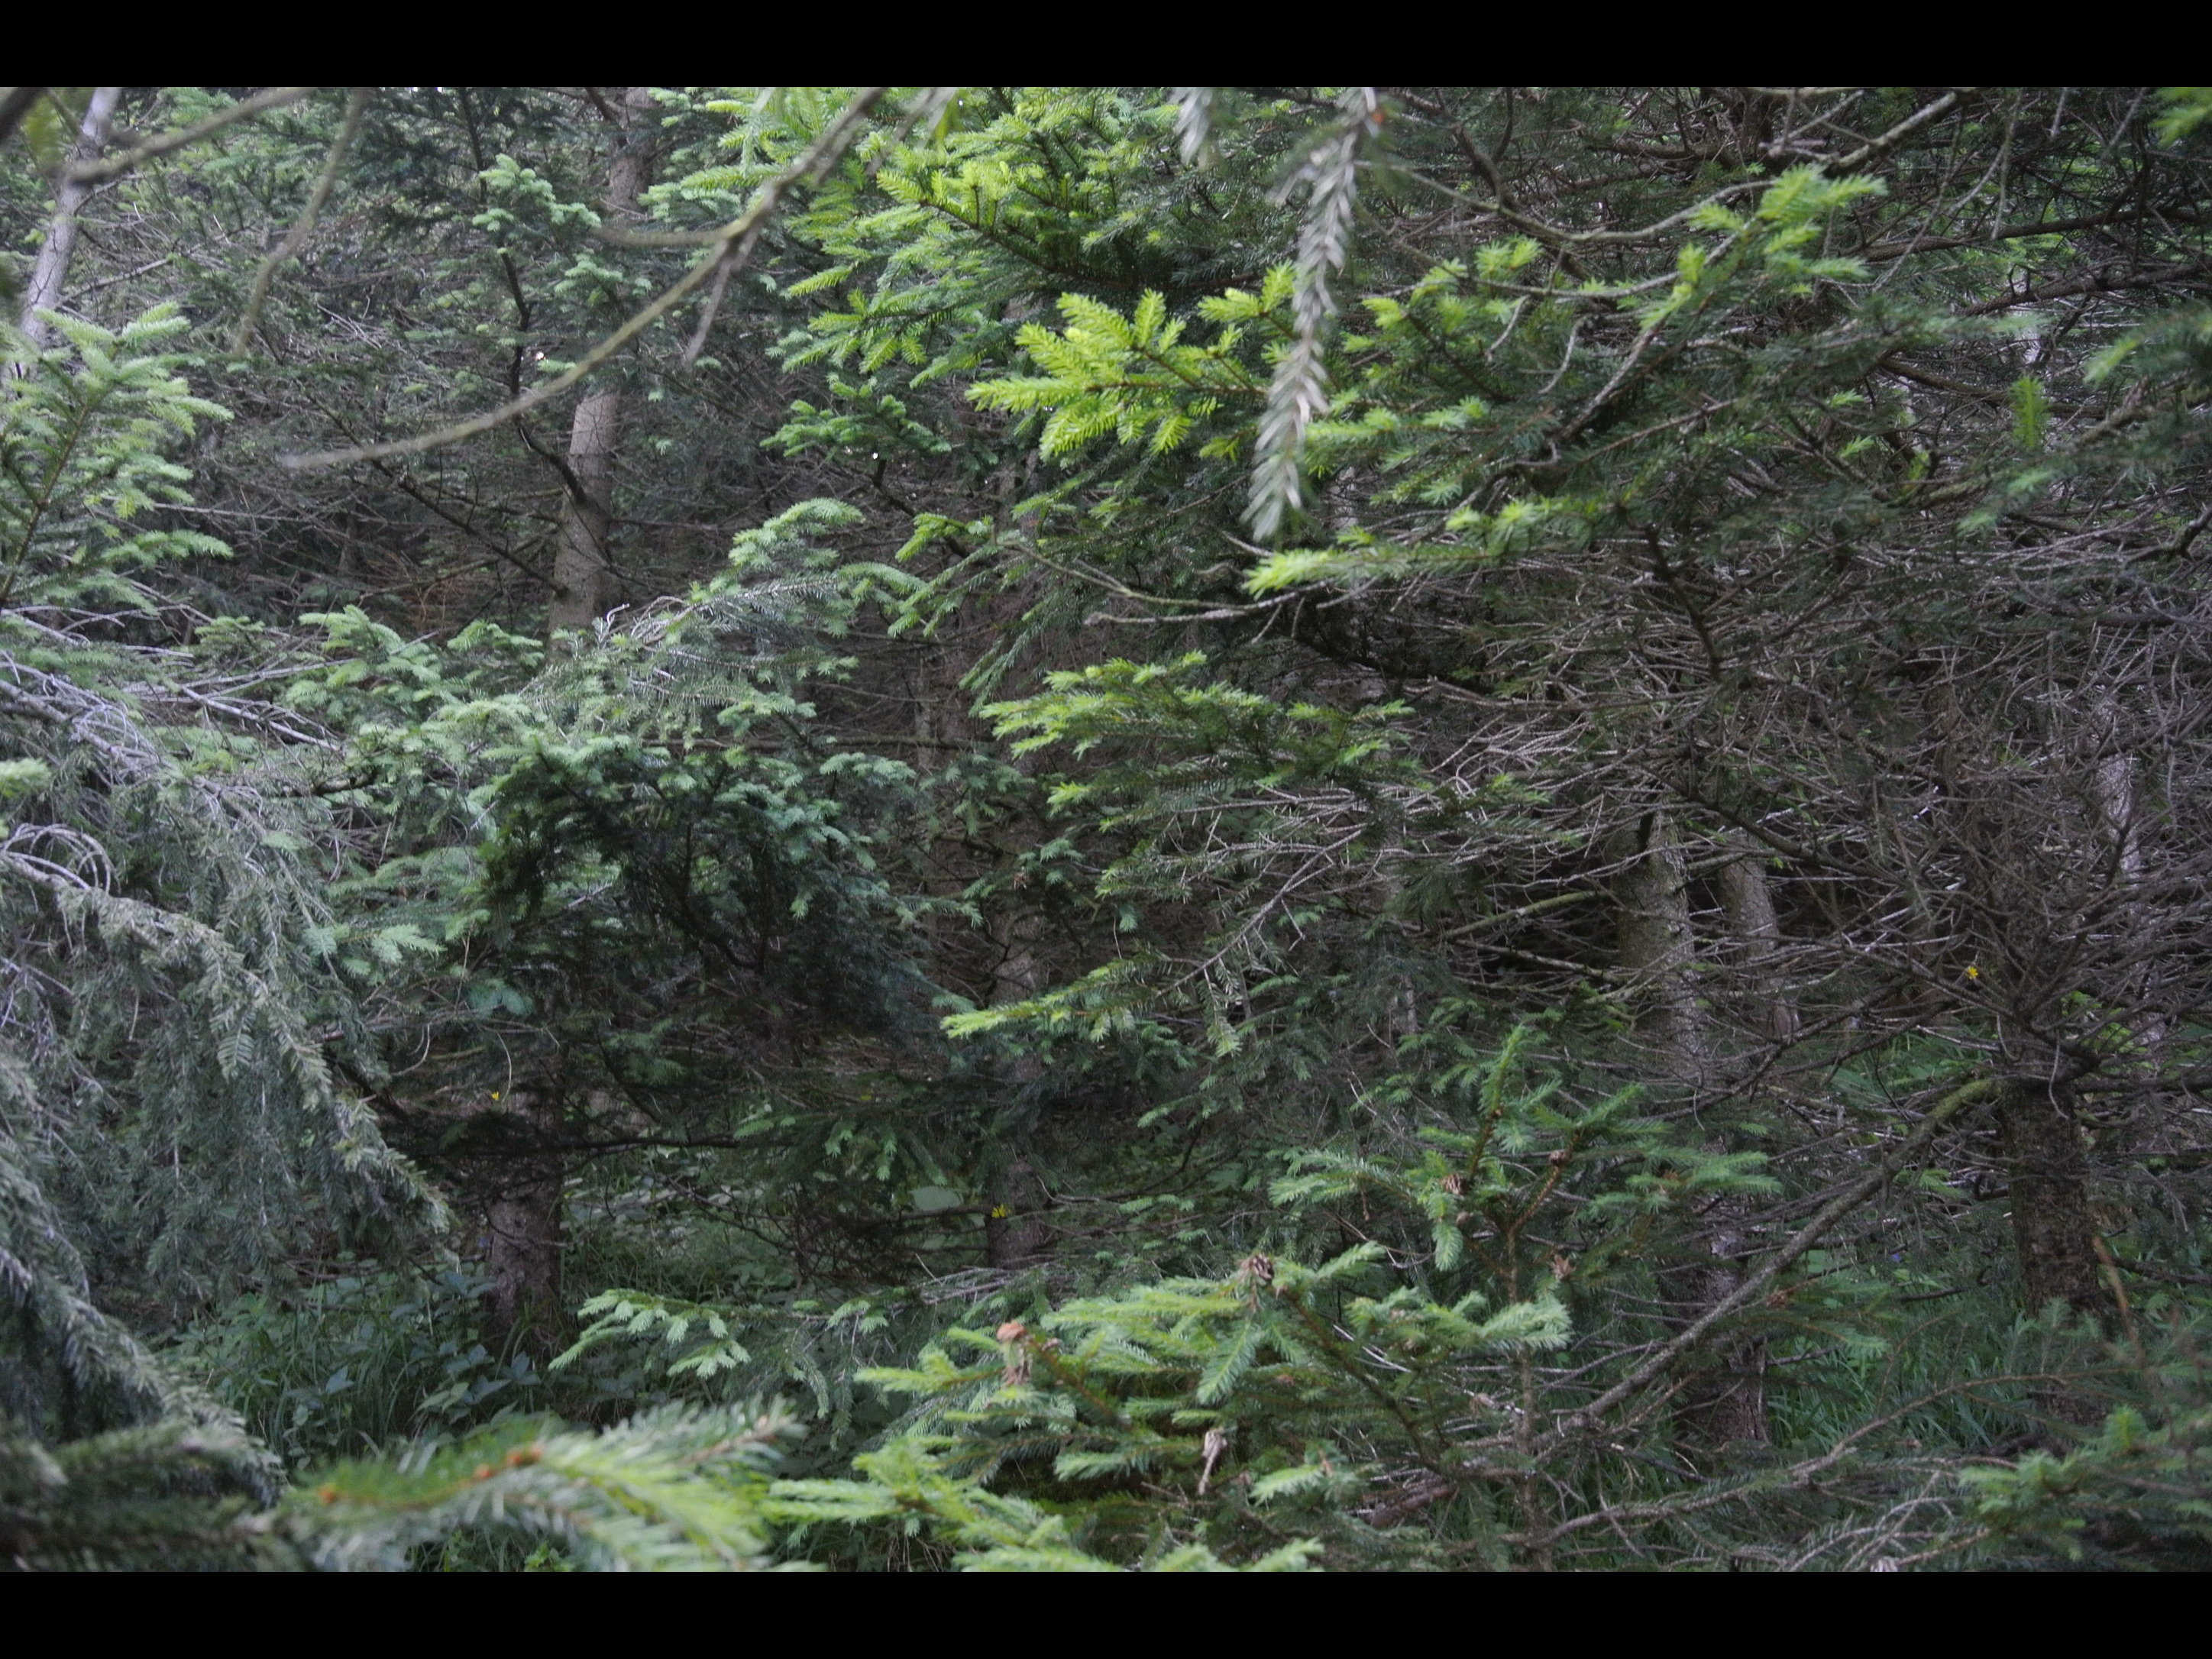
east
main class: Woodland
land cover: Spruce dominated coniferous woodland
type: alpine coniferous forest
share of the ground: > 75 %
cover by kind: coniferous forest trees 90 %, herbaceous plants 10 %
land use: Forestry
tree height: > 5 m
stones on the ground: > 50 %
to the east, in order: Spruce dominated coniferous woodland; Rock outcrops; Tracks; Rocks and stones; Spruce dominated coniferous woodland
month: June
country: AT
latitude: 47.8574
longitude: 15.3879
